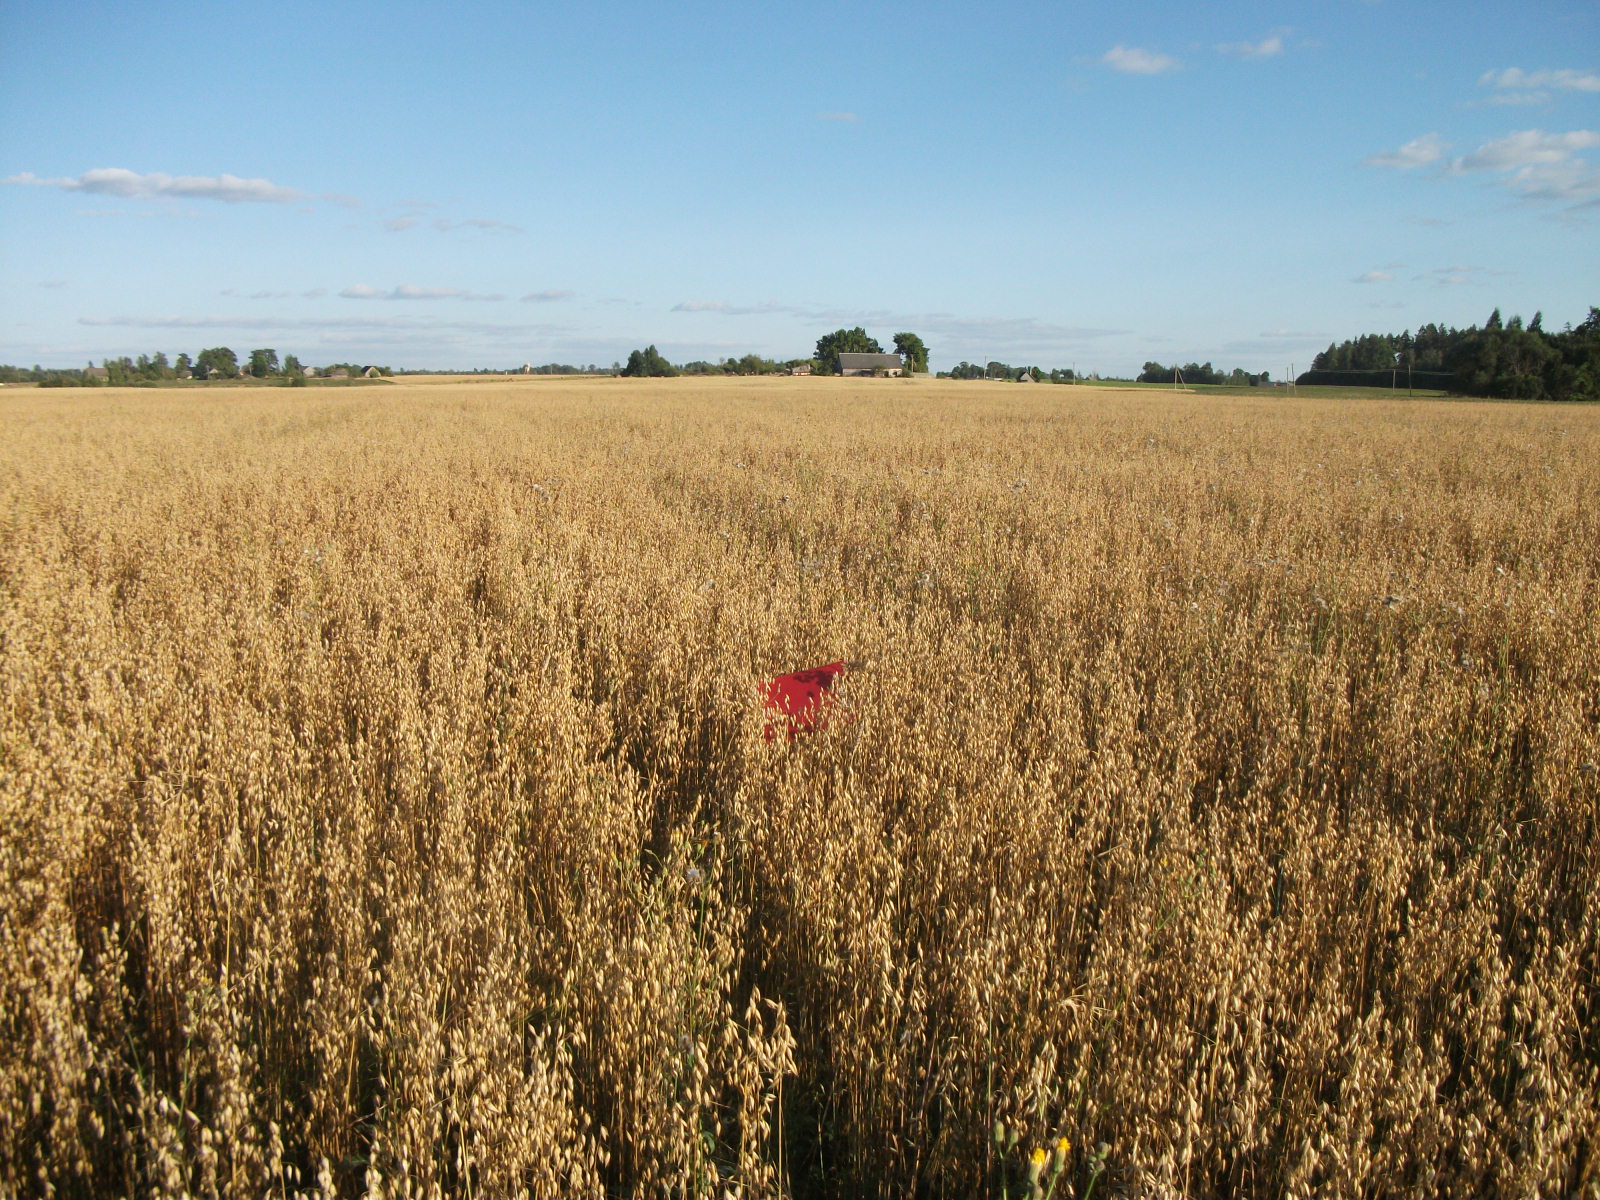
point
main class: Cropland
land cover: Oats
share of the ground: > 75 %
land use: Agriculture (excluding fallow land and kitchen gardens)
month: August
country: LV
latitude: 56.3612
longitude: 26.3464
